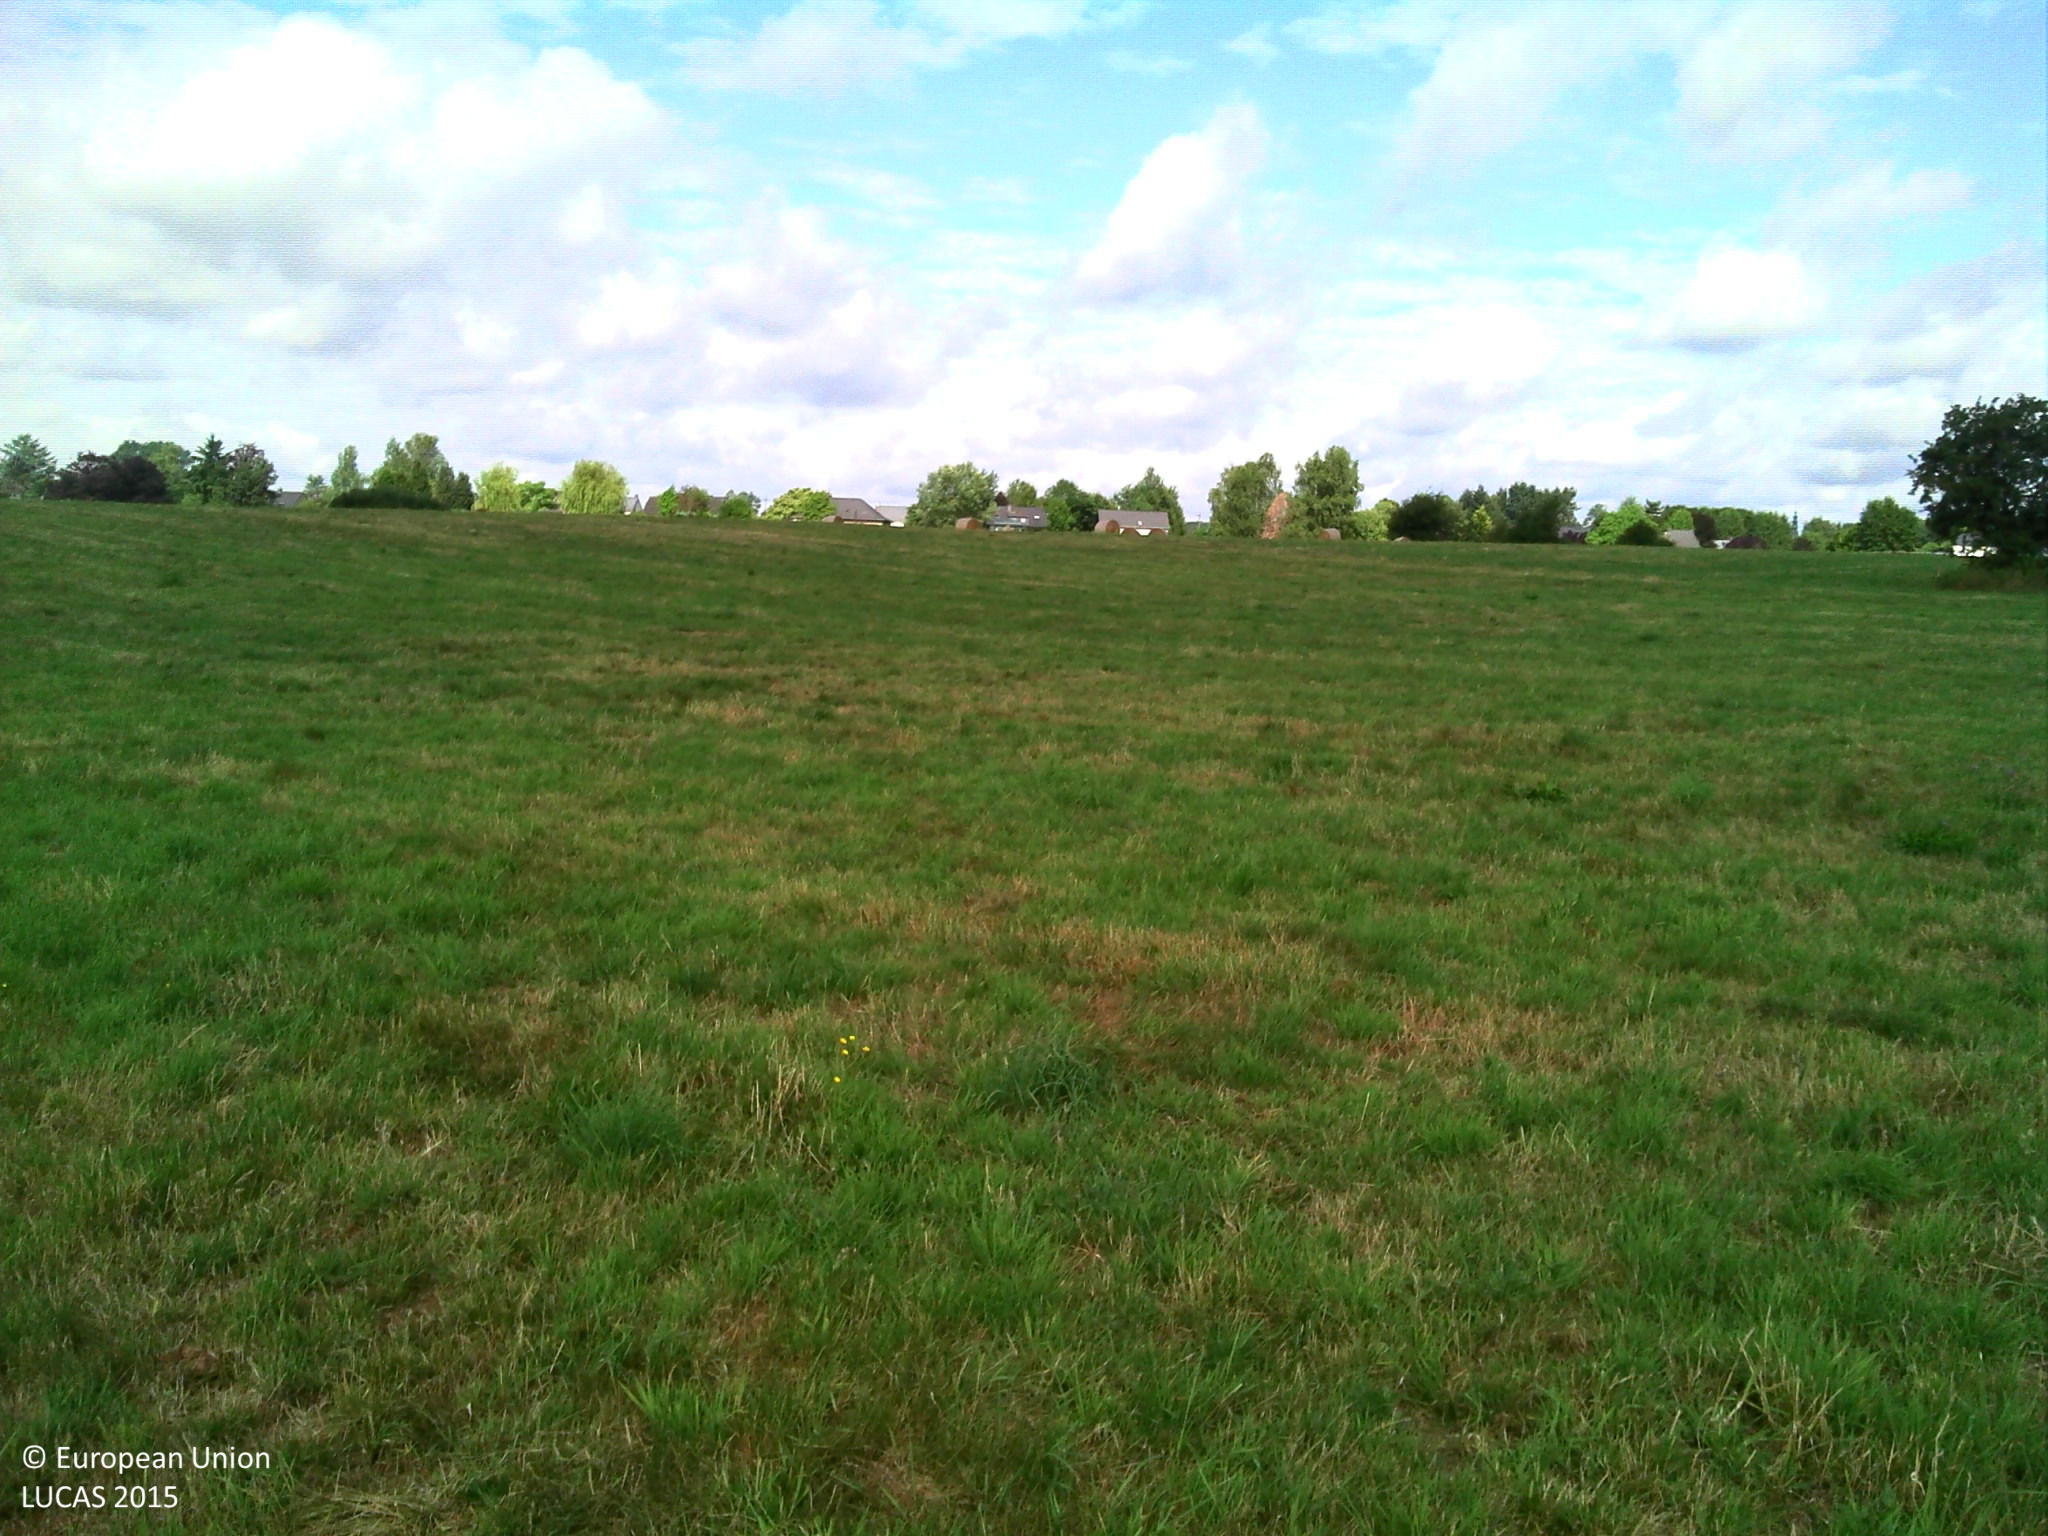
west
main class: Grassland
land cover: Grassland without tree/shrub cover
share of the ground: > 75 %
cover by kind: herbaceous plants 100 %
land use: Agriculture (excluding fallow land and kitchen gardens)
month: July
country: BE
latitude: 49.6922
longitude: 5.3265
